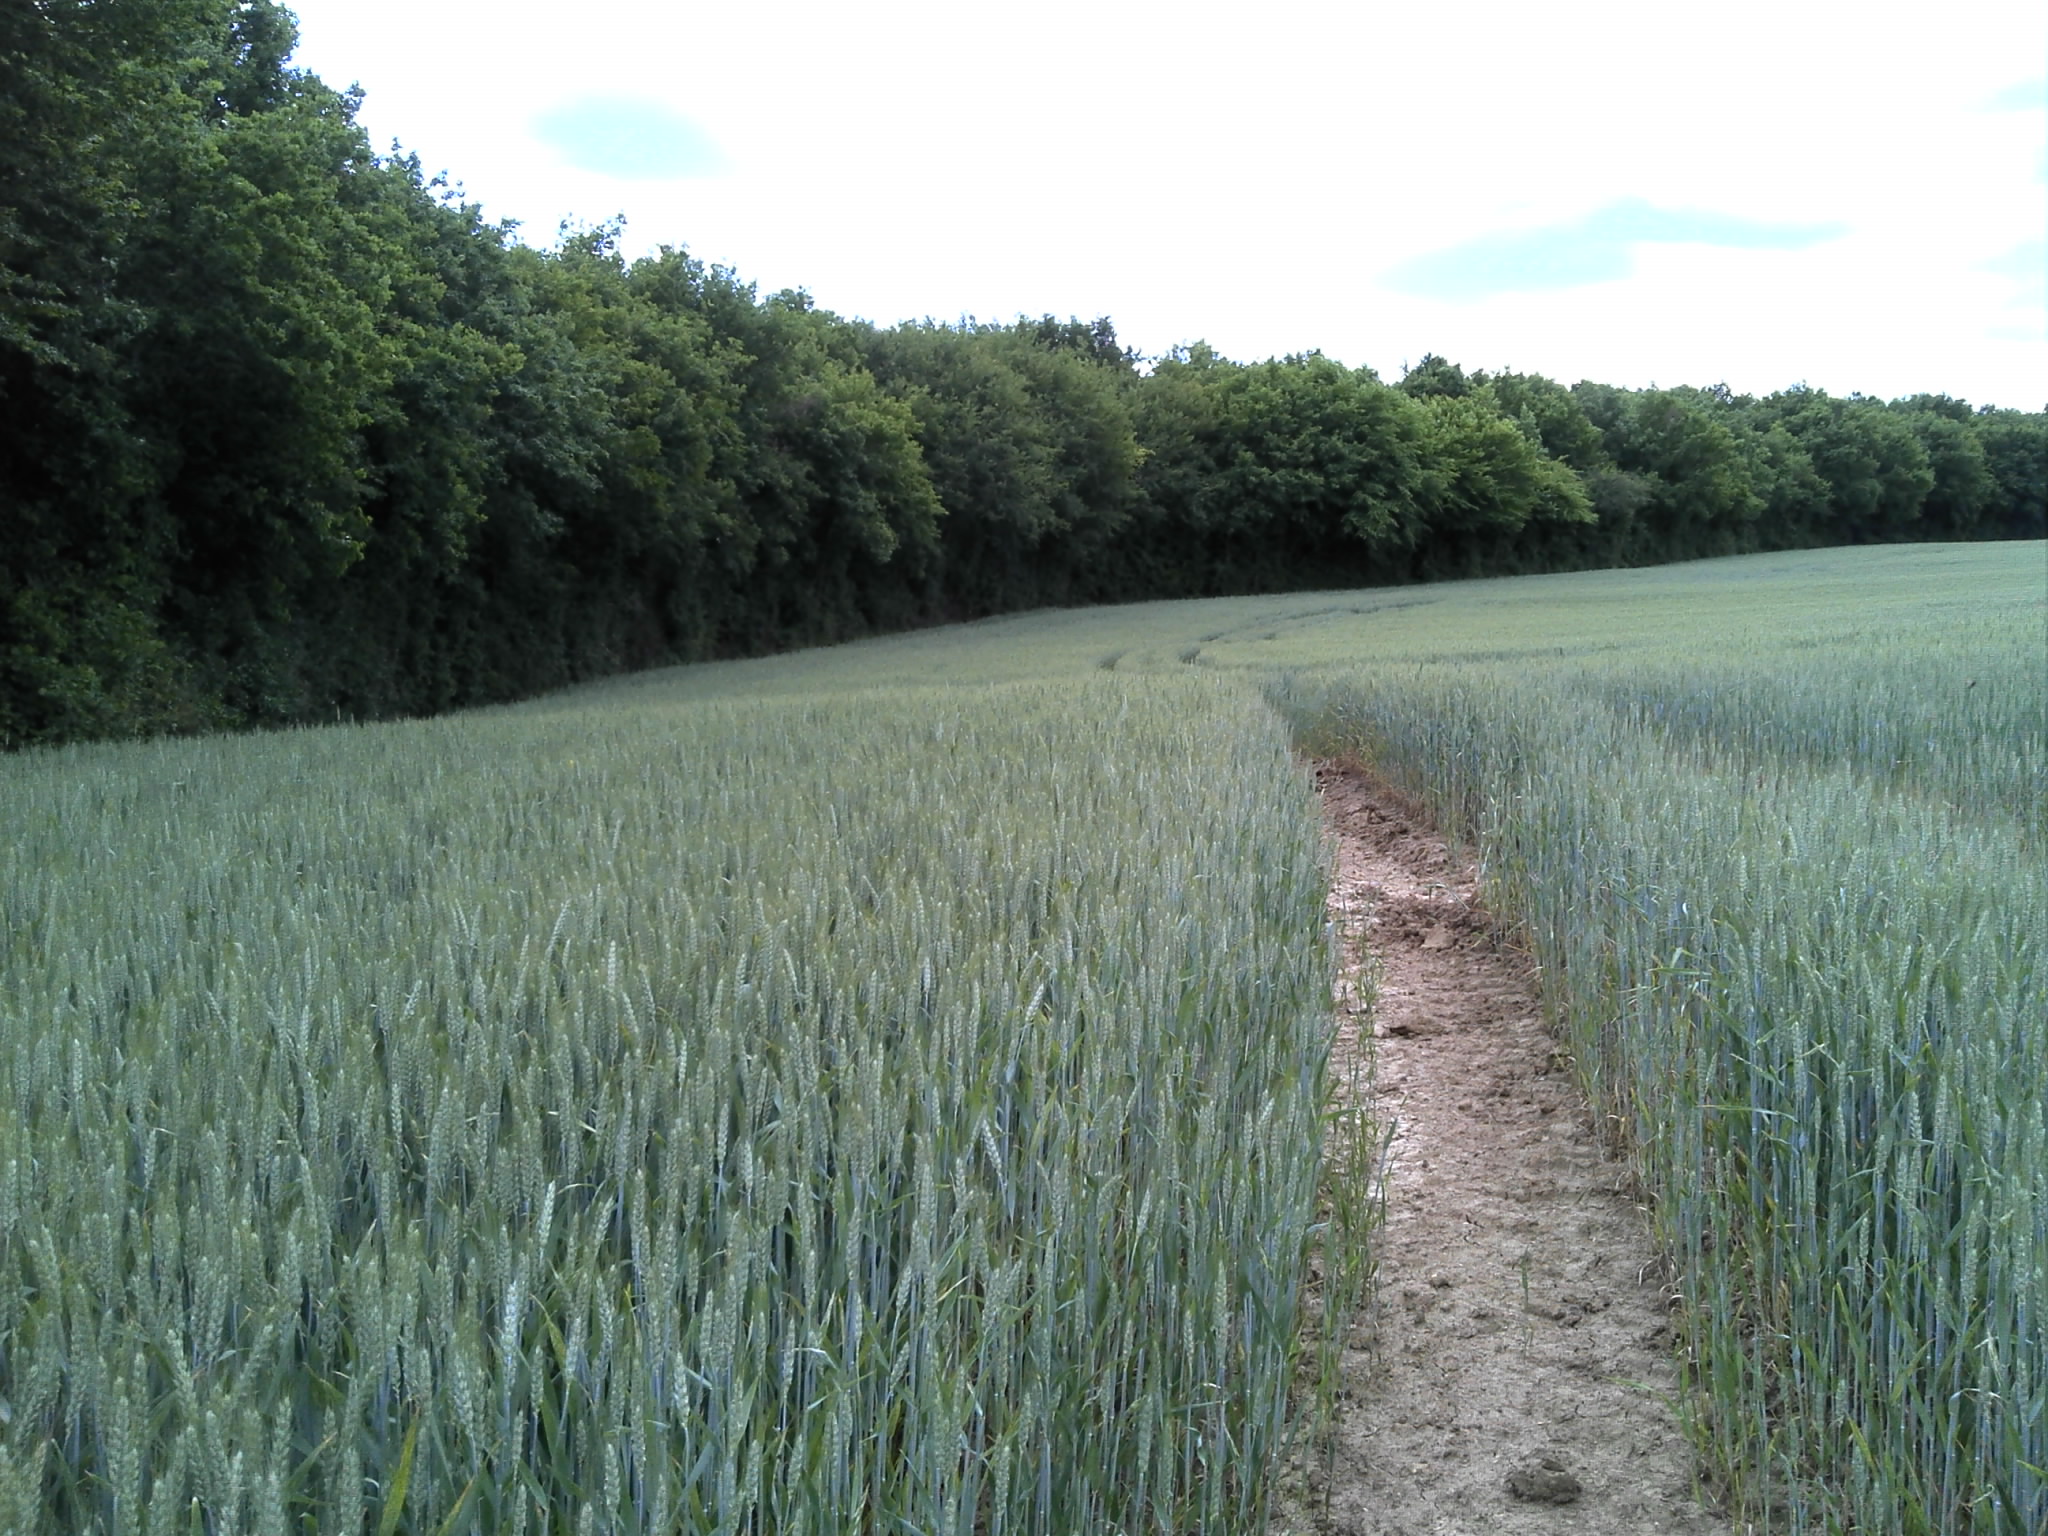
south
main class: Cropland
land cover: Common wheat
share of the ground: > 75 %
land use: Agriculture (excluding fallow land and kitchen gardens)
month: May
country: FR
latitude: 46.5912
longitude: 1.4924
